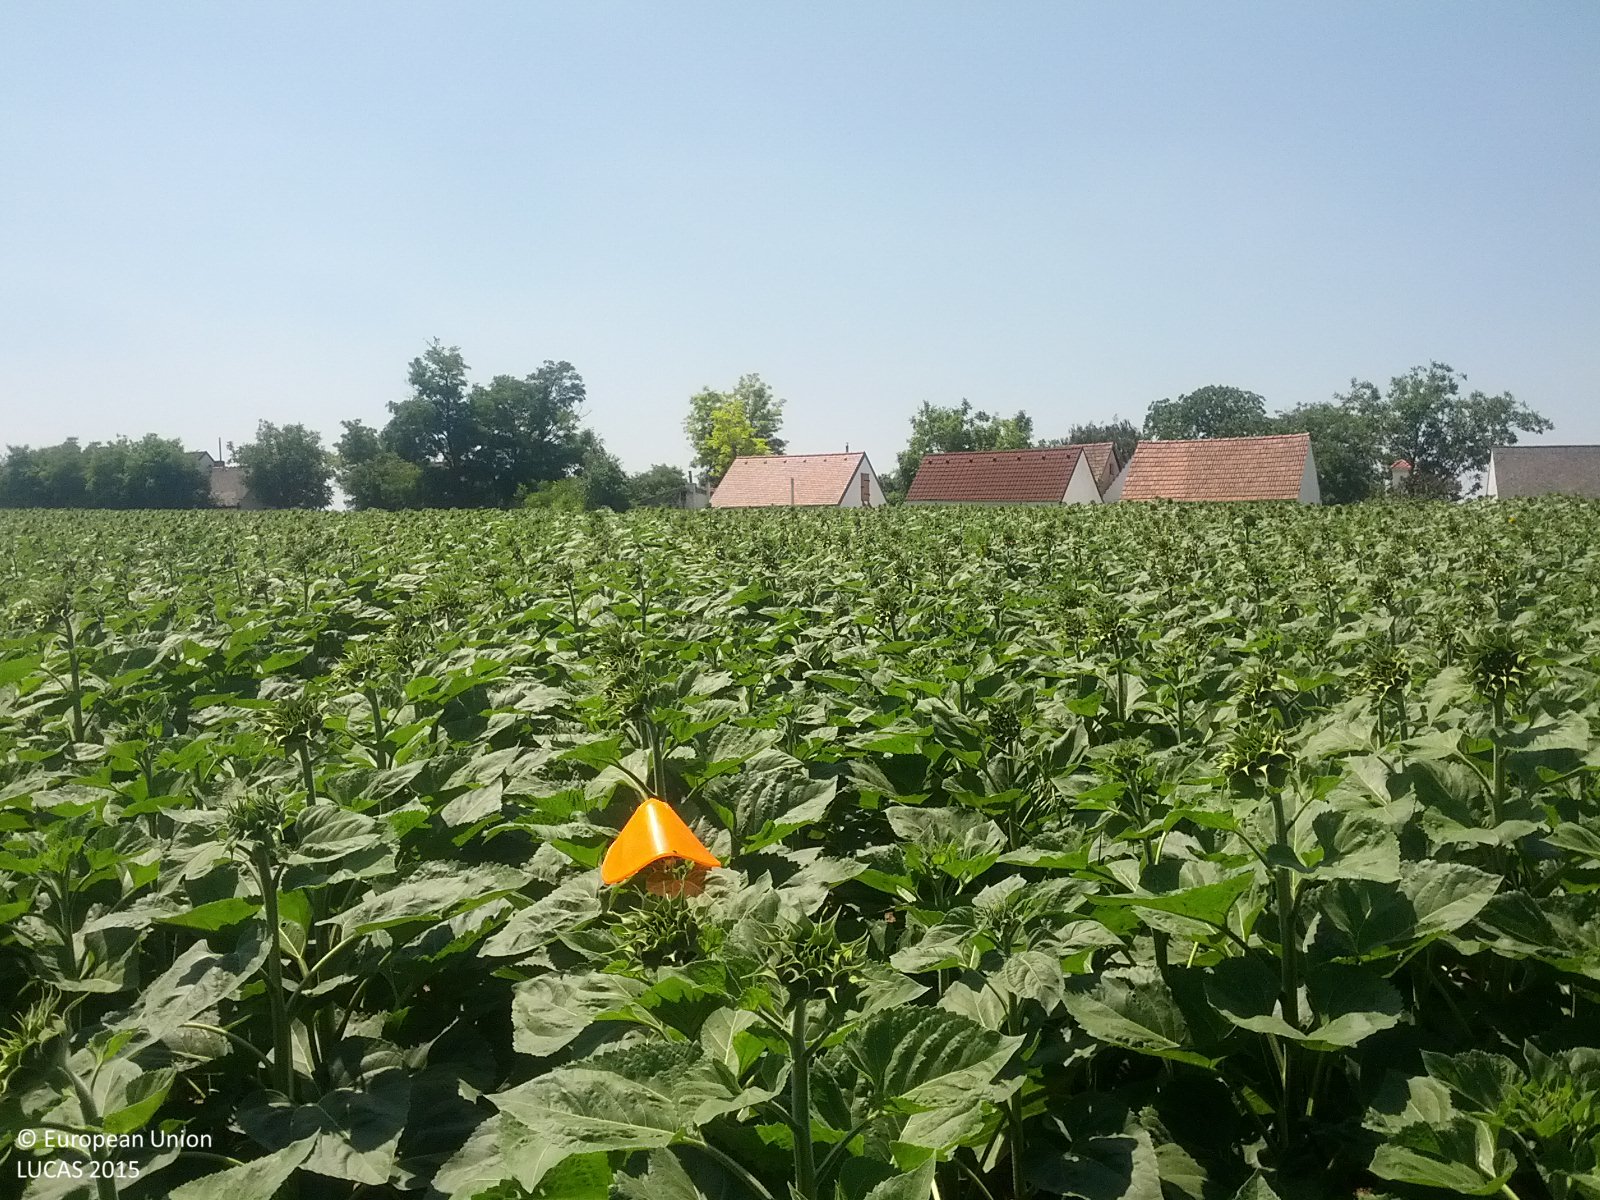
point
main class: Cropland
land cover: Sunflower
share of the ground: > 75 %
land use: Agriculture (excluding fallow land and kitchen gardens)
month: July
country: AT
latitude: 48.5506
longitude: 16.5768
